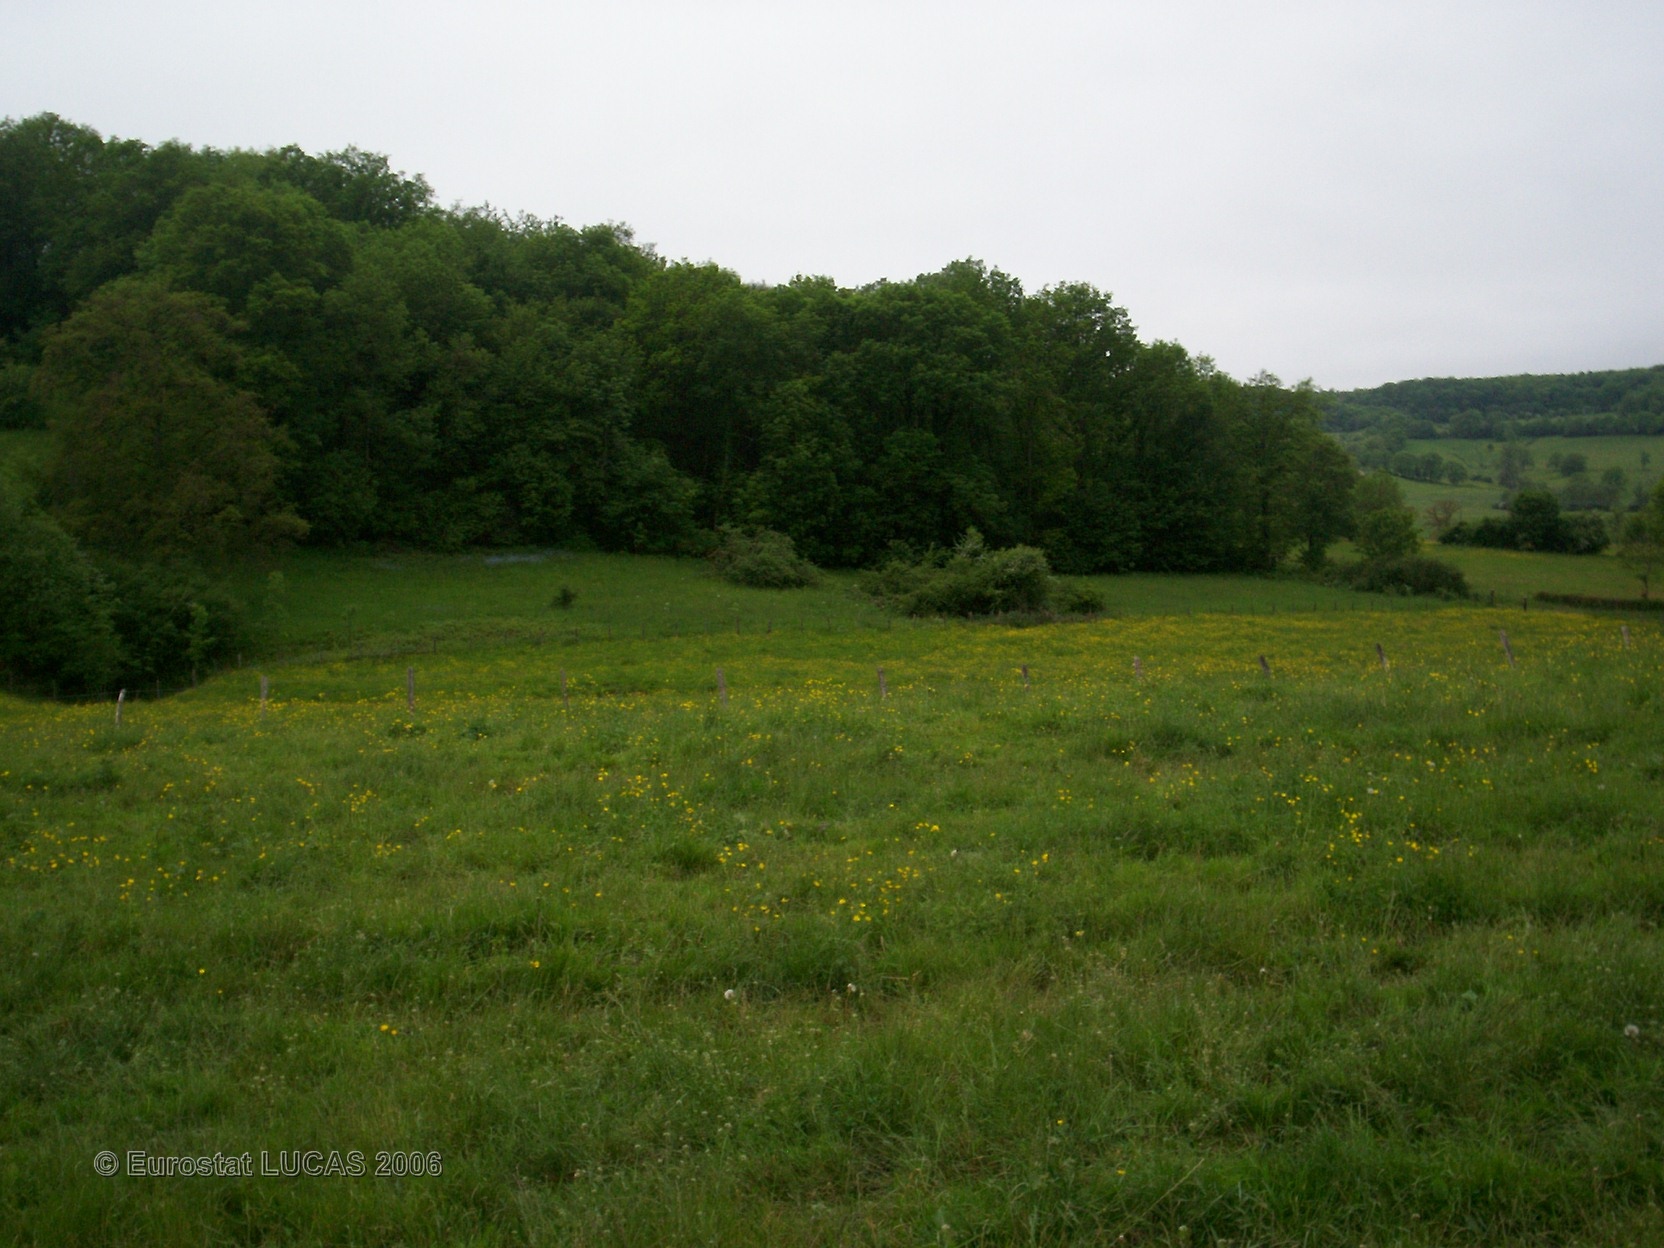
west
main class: Grassland
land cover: Grassland without tree/shrub cover
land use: Agriculture (excluding fallow land and kitchen gardens)
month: May
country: FR
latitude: 47.3728
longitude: 4.6626
